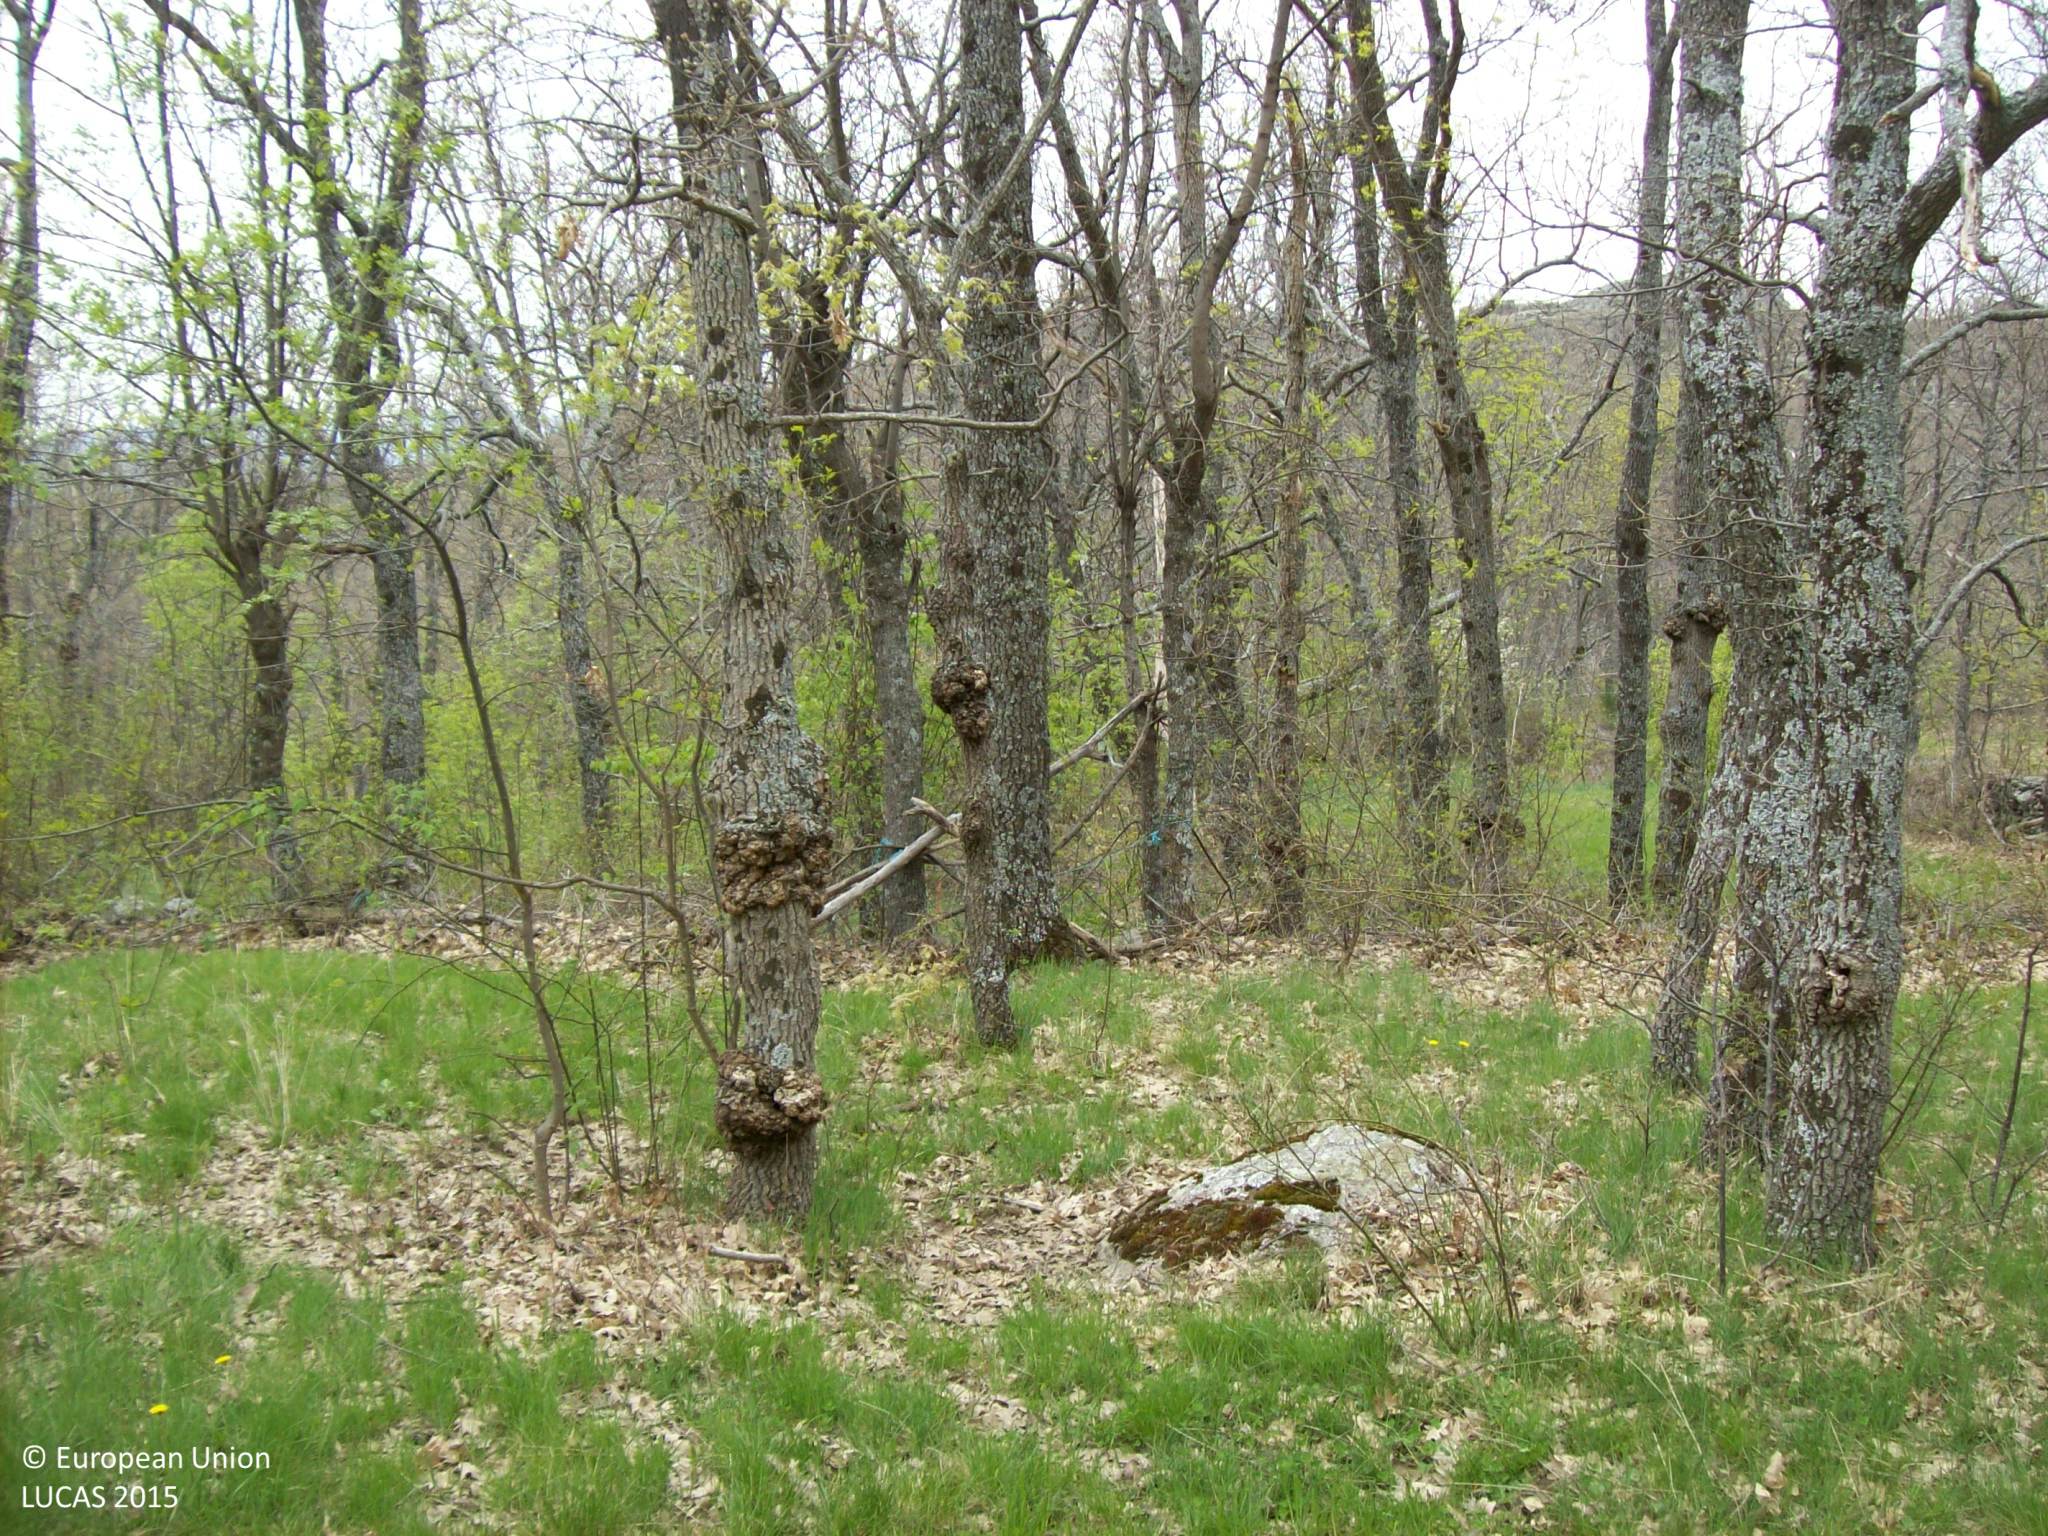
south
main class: Woodland
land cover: Broadleaved woodland
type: thermophilous deciduous forest
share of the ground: 50 - 75 %
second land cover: Grassland without tree/shrub cover
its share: > 75 %
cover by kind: broadleaved forest trees 60 %, herbaceous plants 40 %
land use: Forestry
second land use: Agriculture (excluding fallow land and kitchen gardens)
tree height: > 5 m
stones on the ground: < 10 %
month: April
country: ES
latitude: 40.4726
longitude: -4.8343
